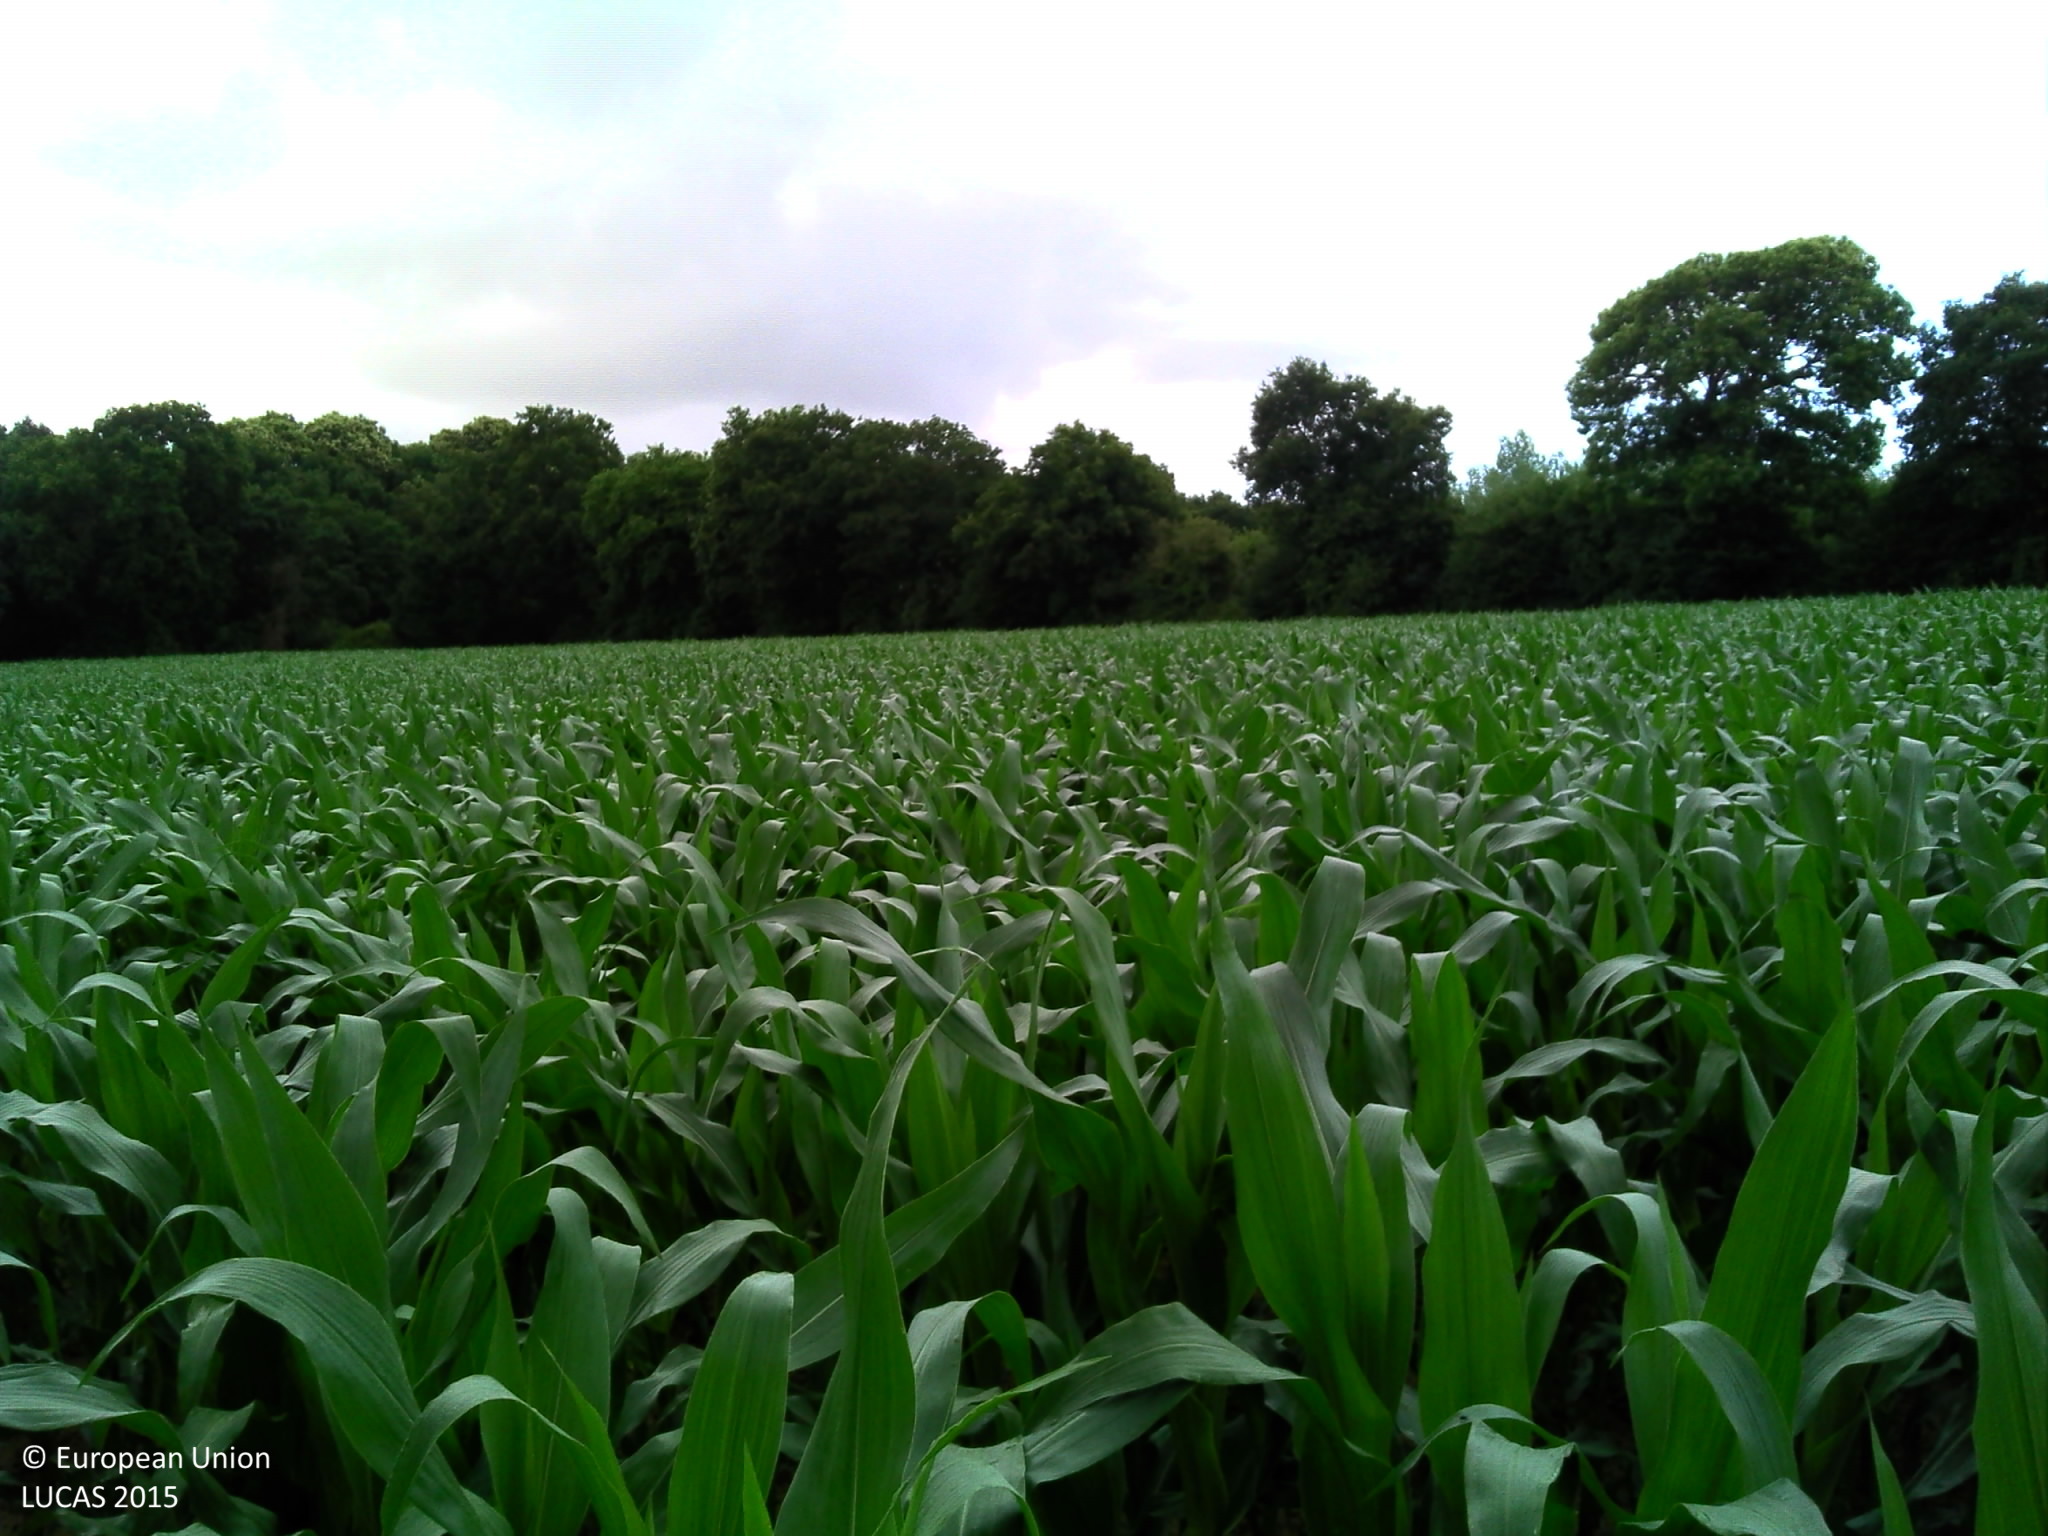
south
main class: Cropland
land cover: Maize
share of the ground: > 75 %
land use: Agriculture (excluding fallow land and kitchen gardens)
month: July
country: FR
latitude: 48.4898
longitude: -2.1942
